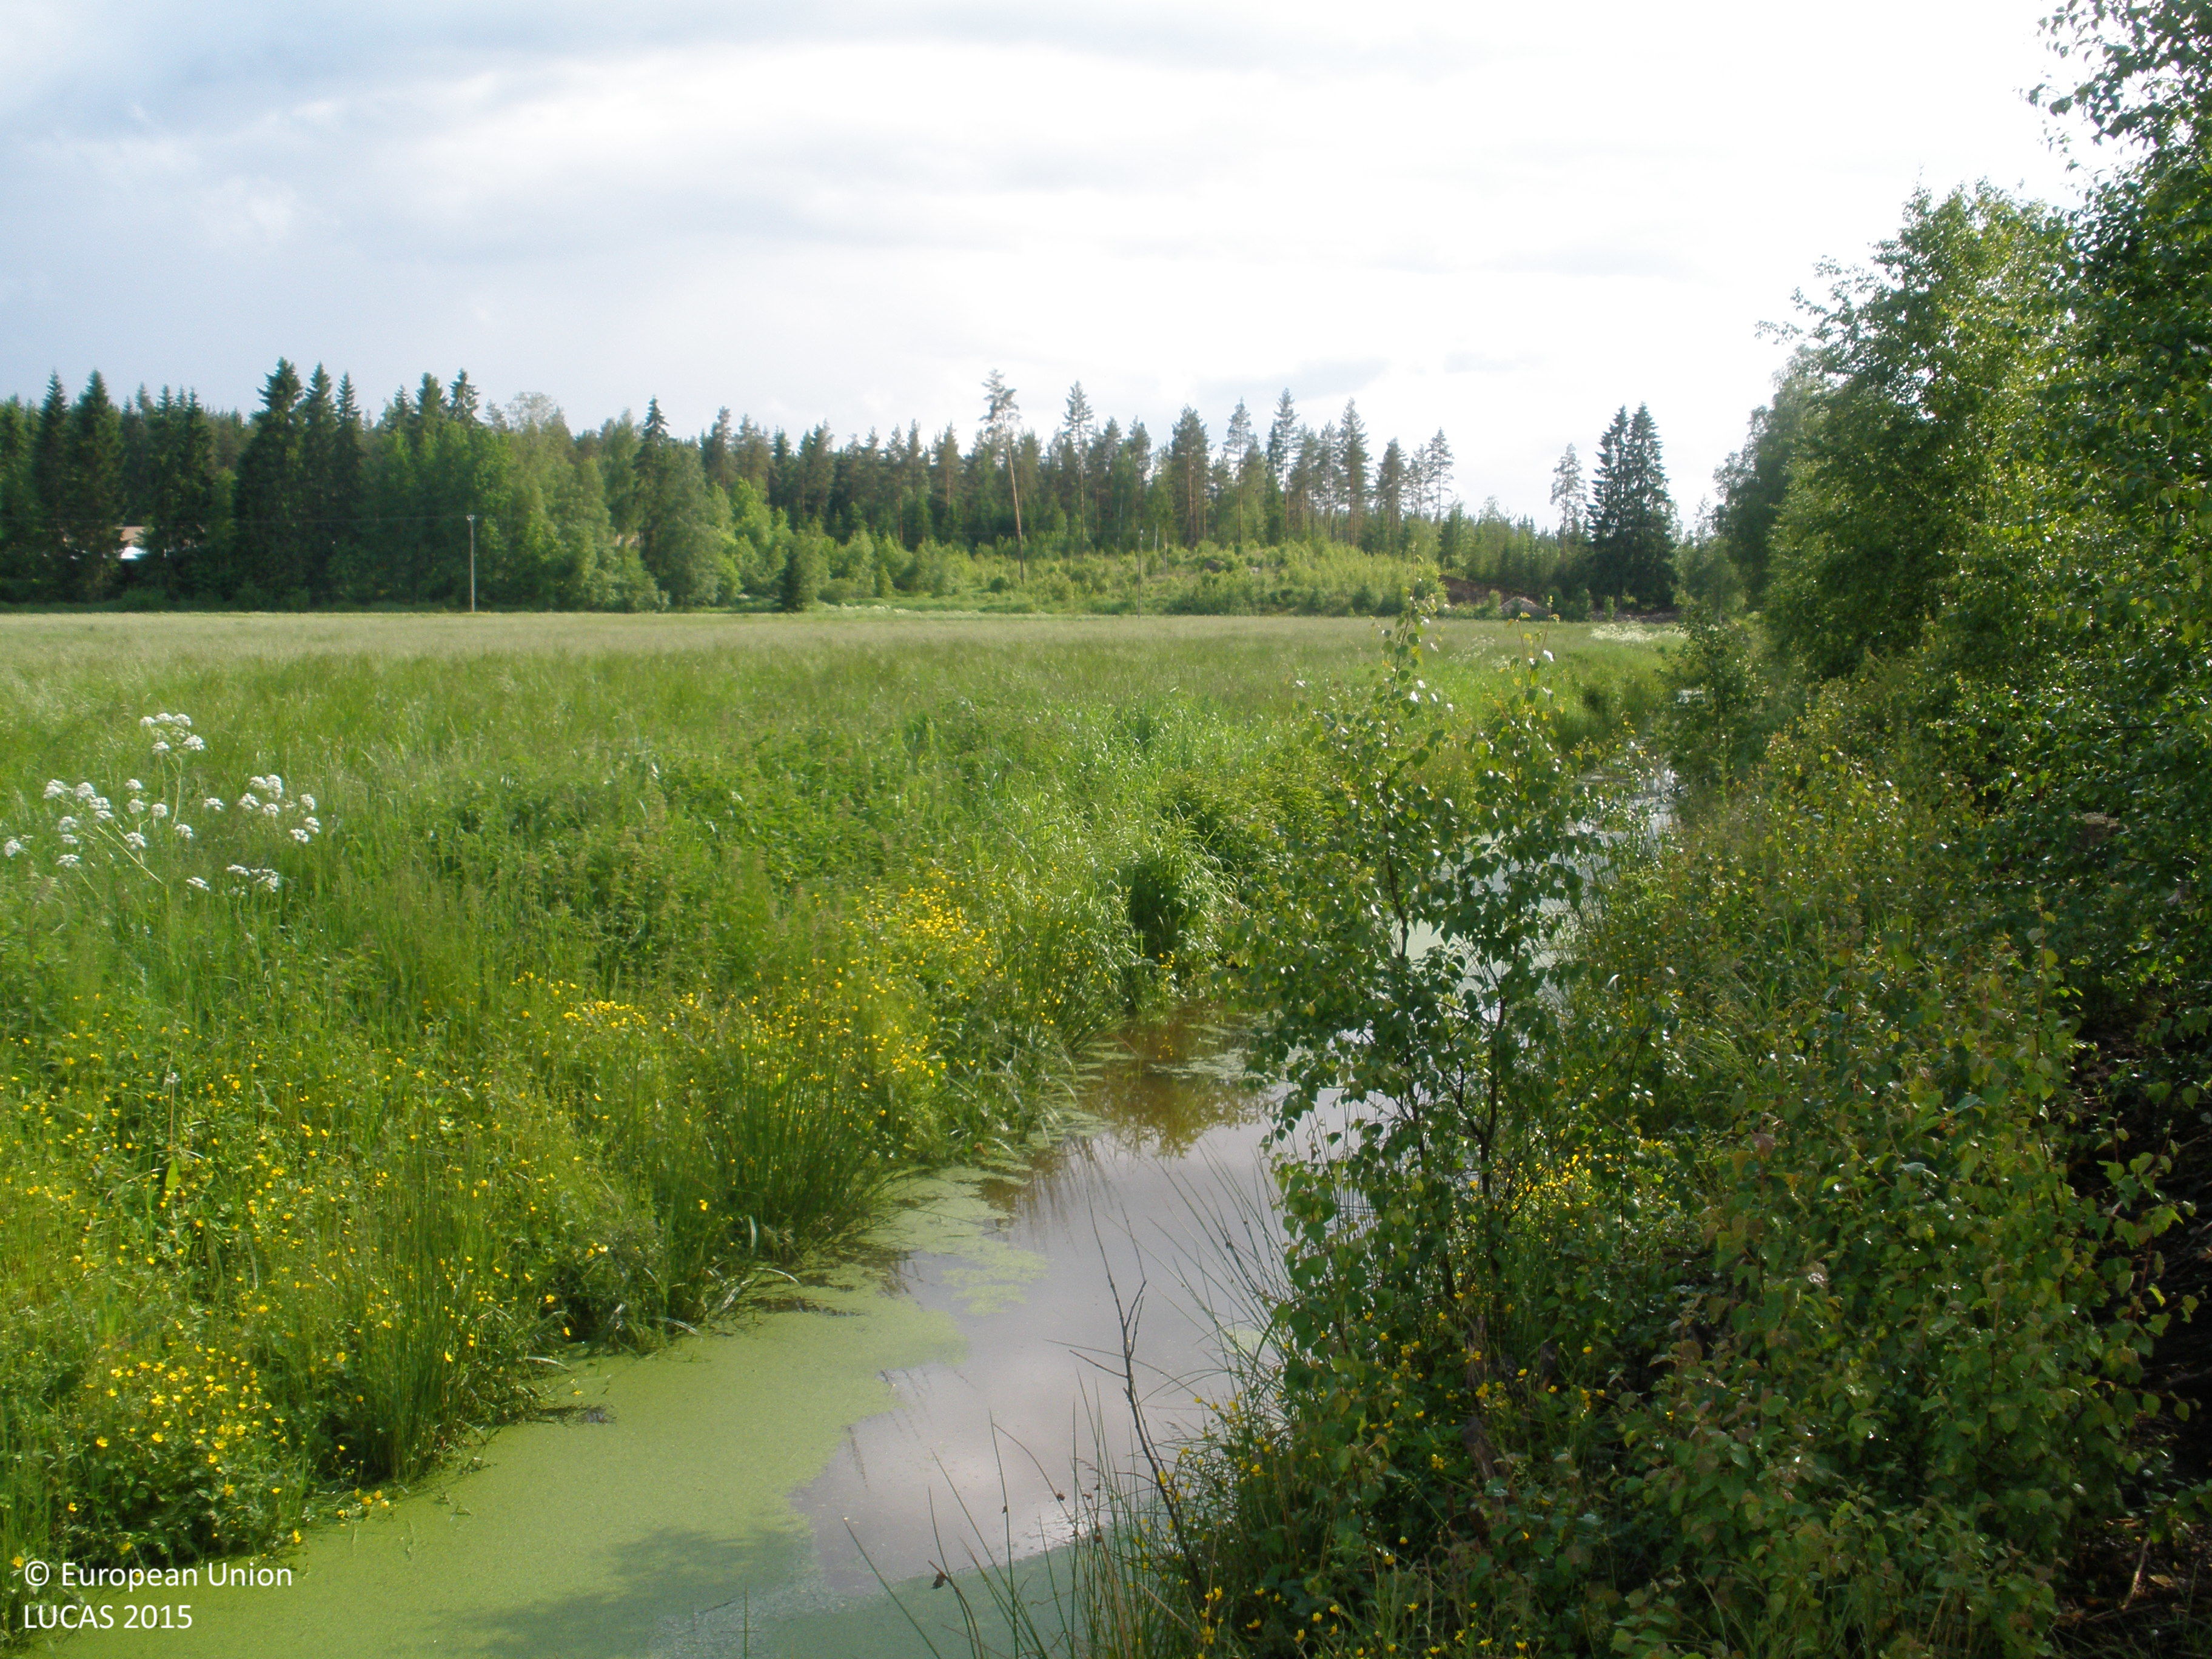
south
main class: Cropland
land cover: Temporary grasslands
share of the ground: > 75 %
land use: Agriculture (excluding fallow land and kitchen gardens)
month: June
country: FI
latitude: 60.9199
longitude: 23.4927
